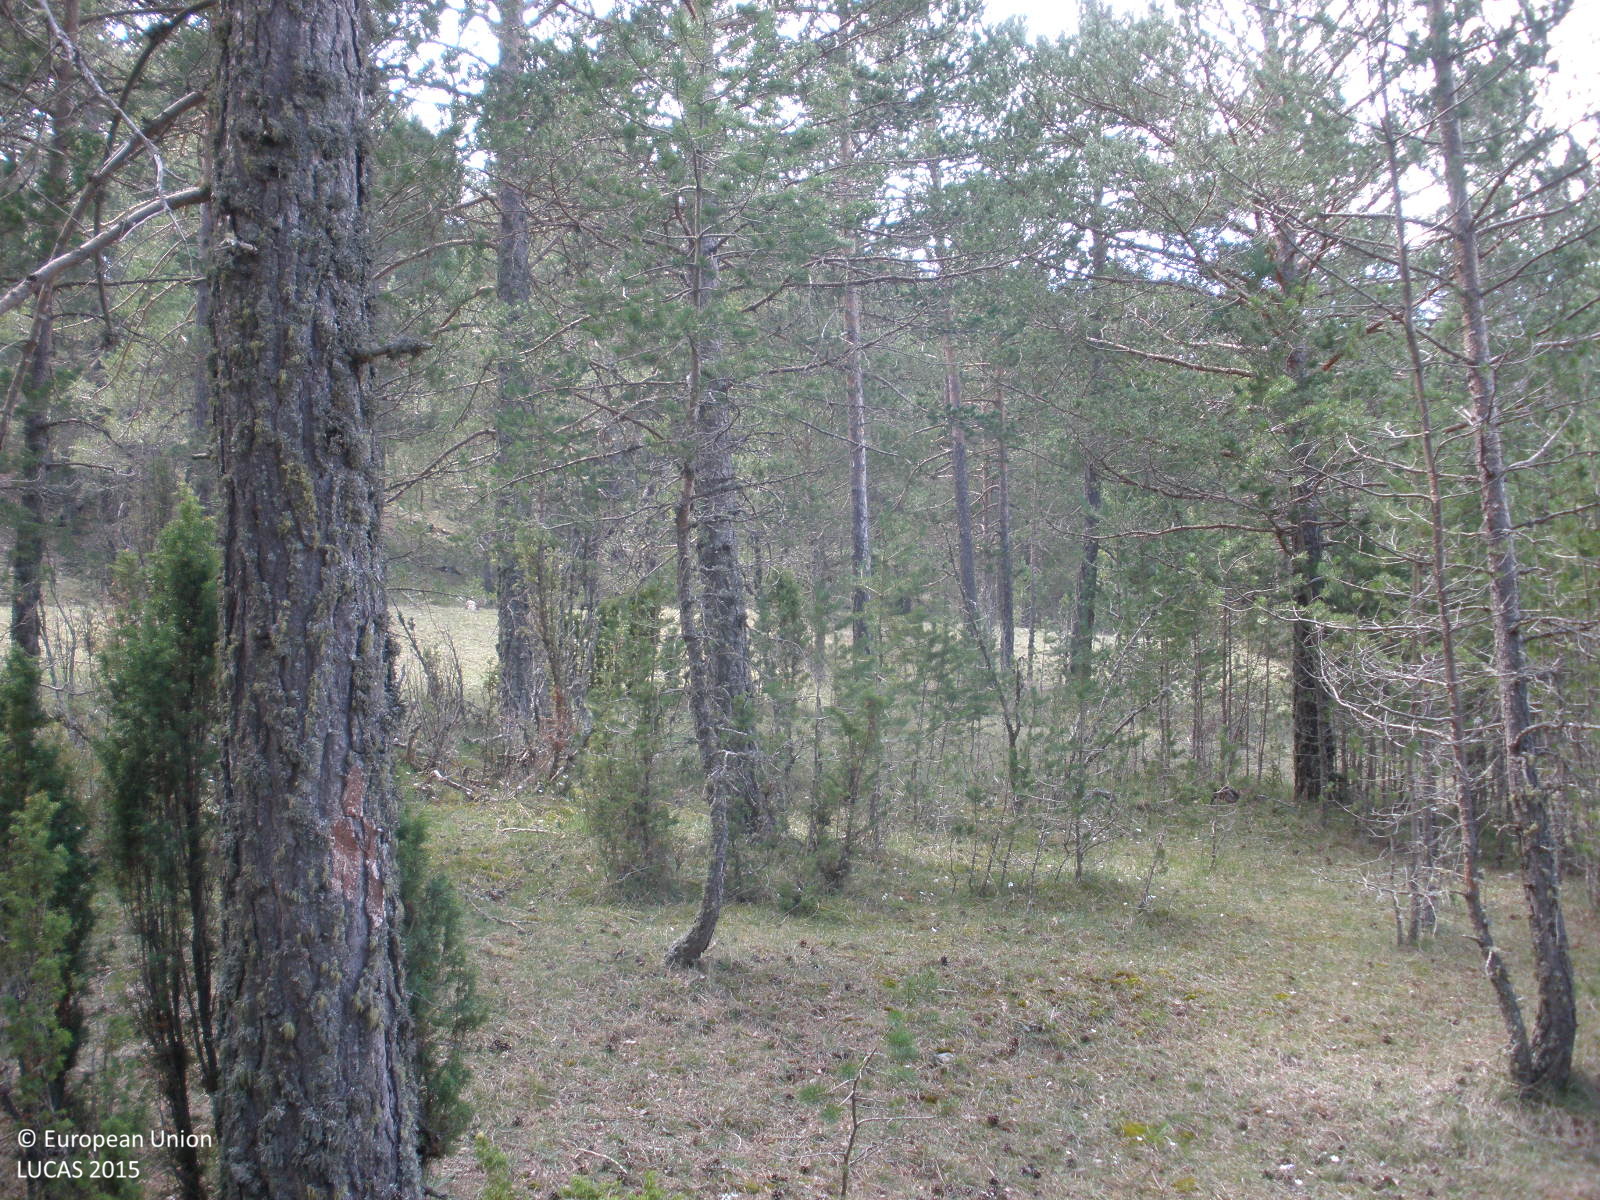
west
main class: Woodland
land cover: Pine dominated coniferous woodland
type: coniferous forest of the mediterranean region
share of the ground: > 75 %
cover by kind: coniferous forest trees 70 %, herbaceous plants 30 %
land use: Semi-natural and natural areas not in use
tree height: > 5 m
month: April
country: ES
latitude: 40.4050
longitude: -0.7433
